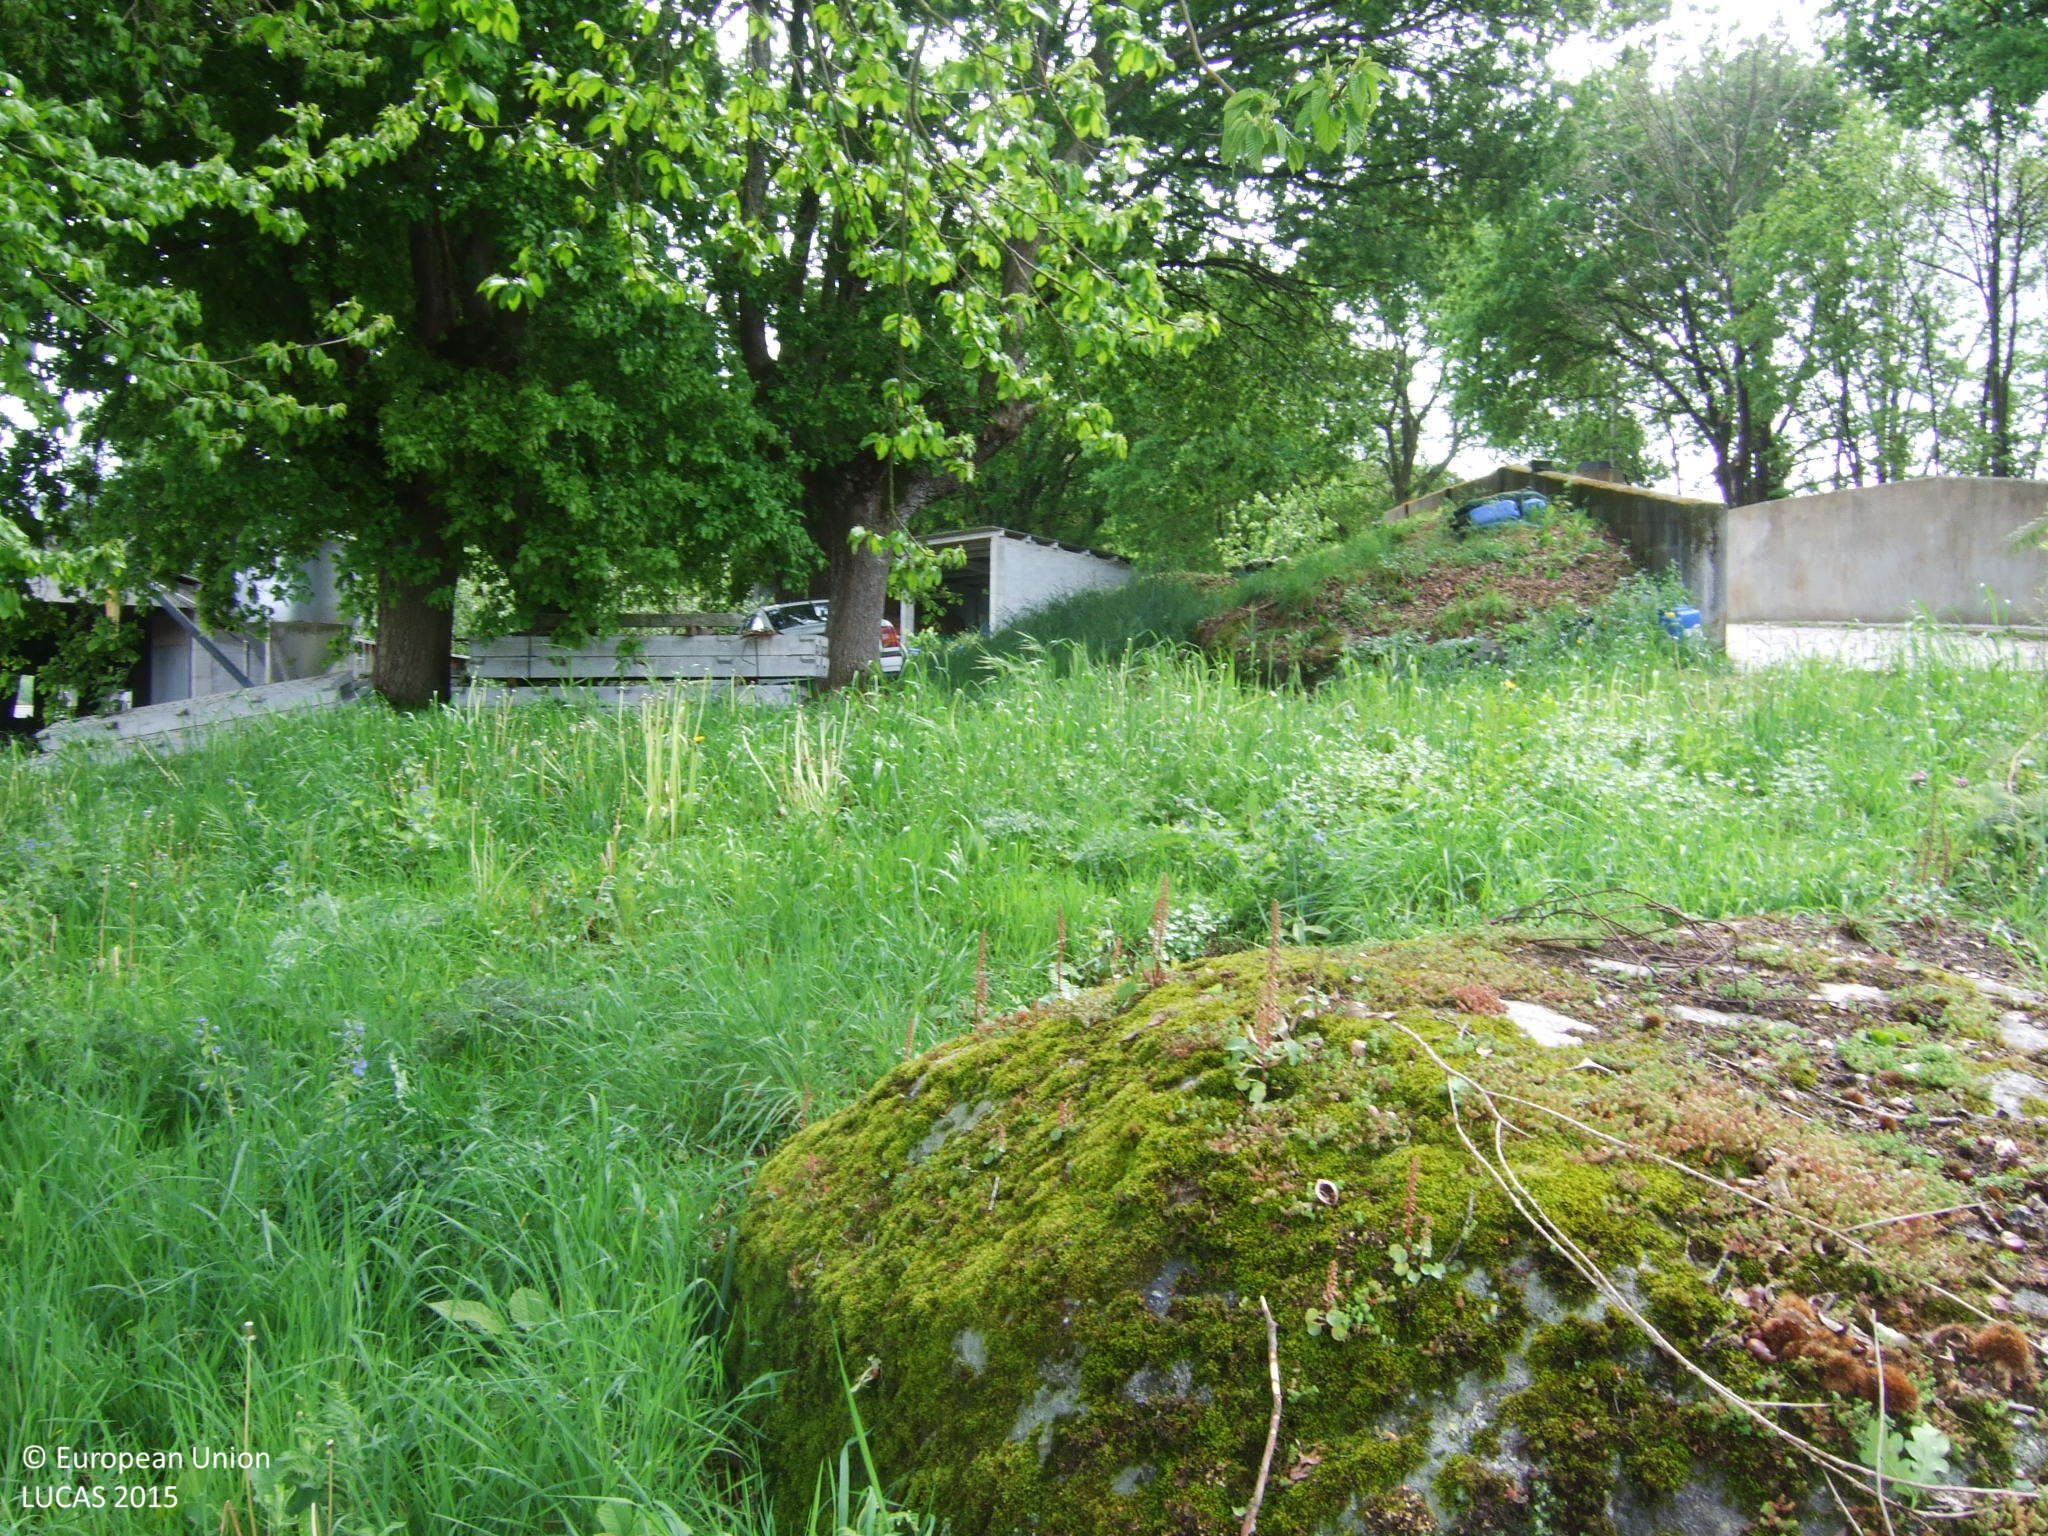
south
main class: Grassland
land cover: Grassland without tree/shrub cover
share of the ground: > 75 %
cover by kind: herbaceous plants 100 %
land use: Residential
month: May
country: ES
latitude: 42.8214
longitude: -7.5534
